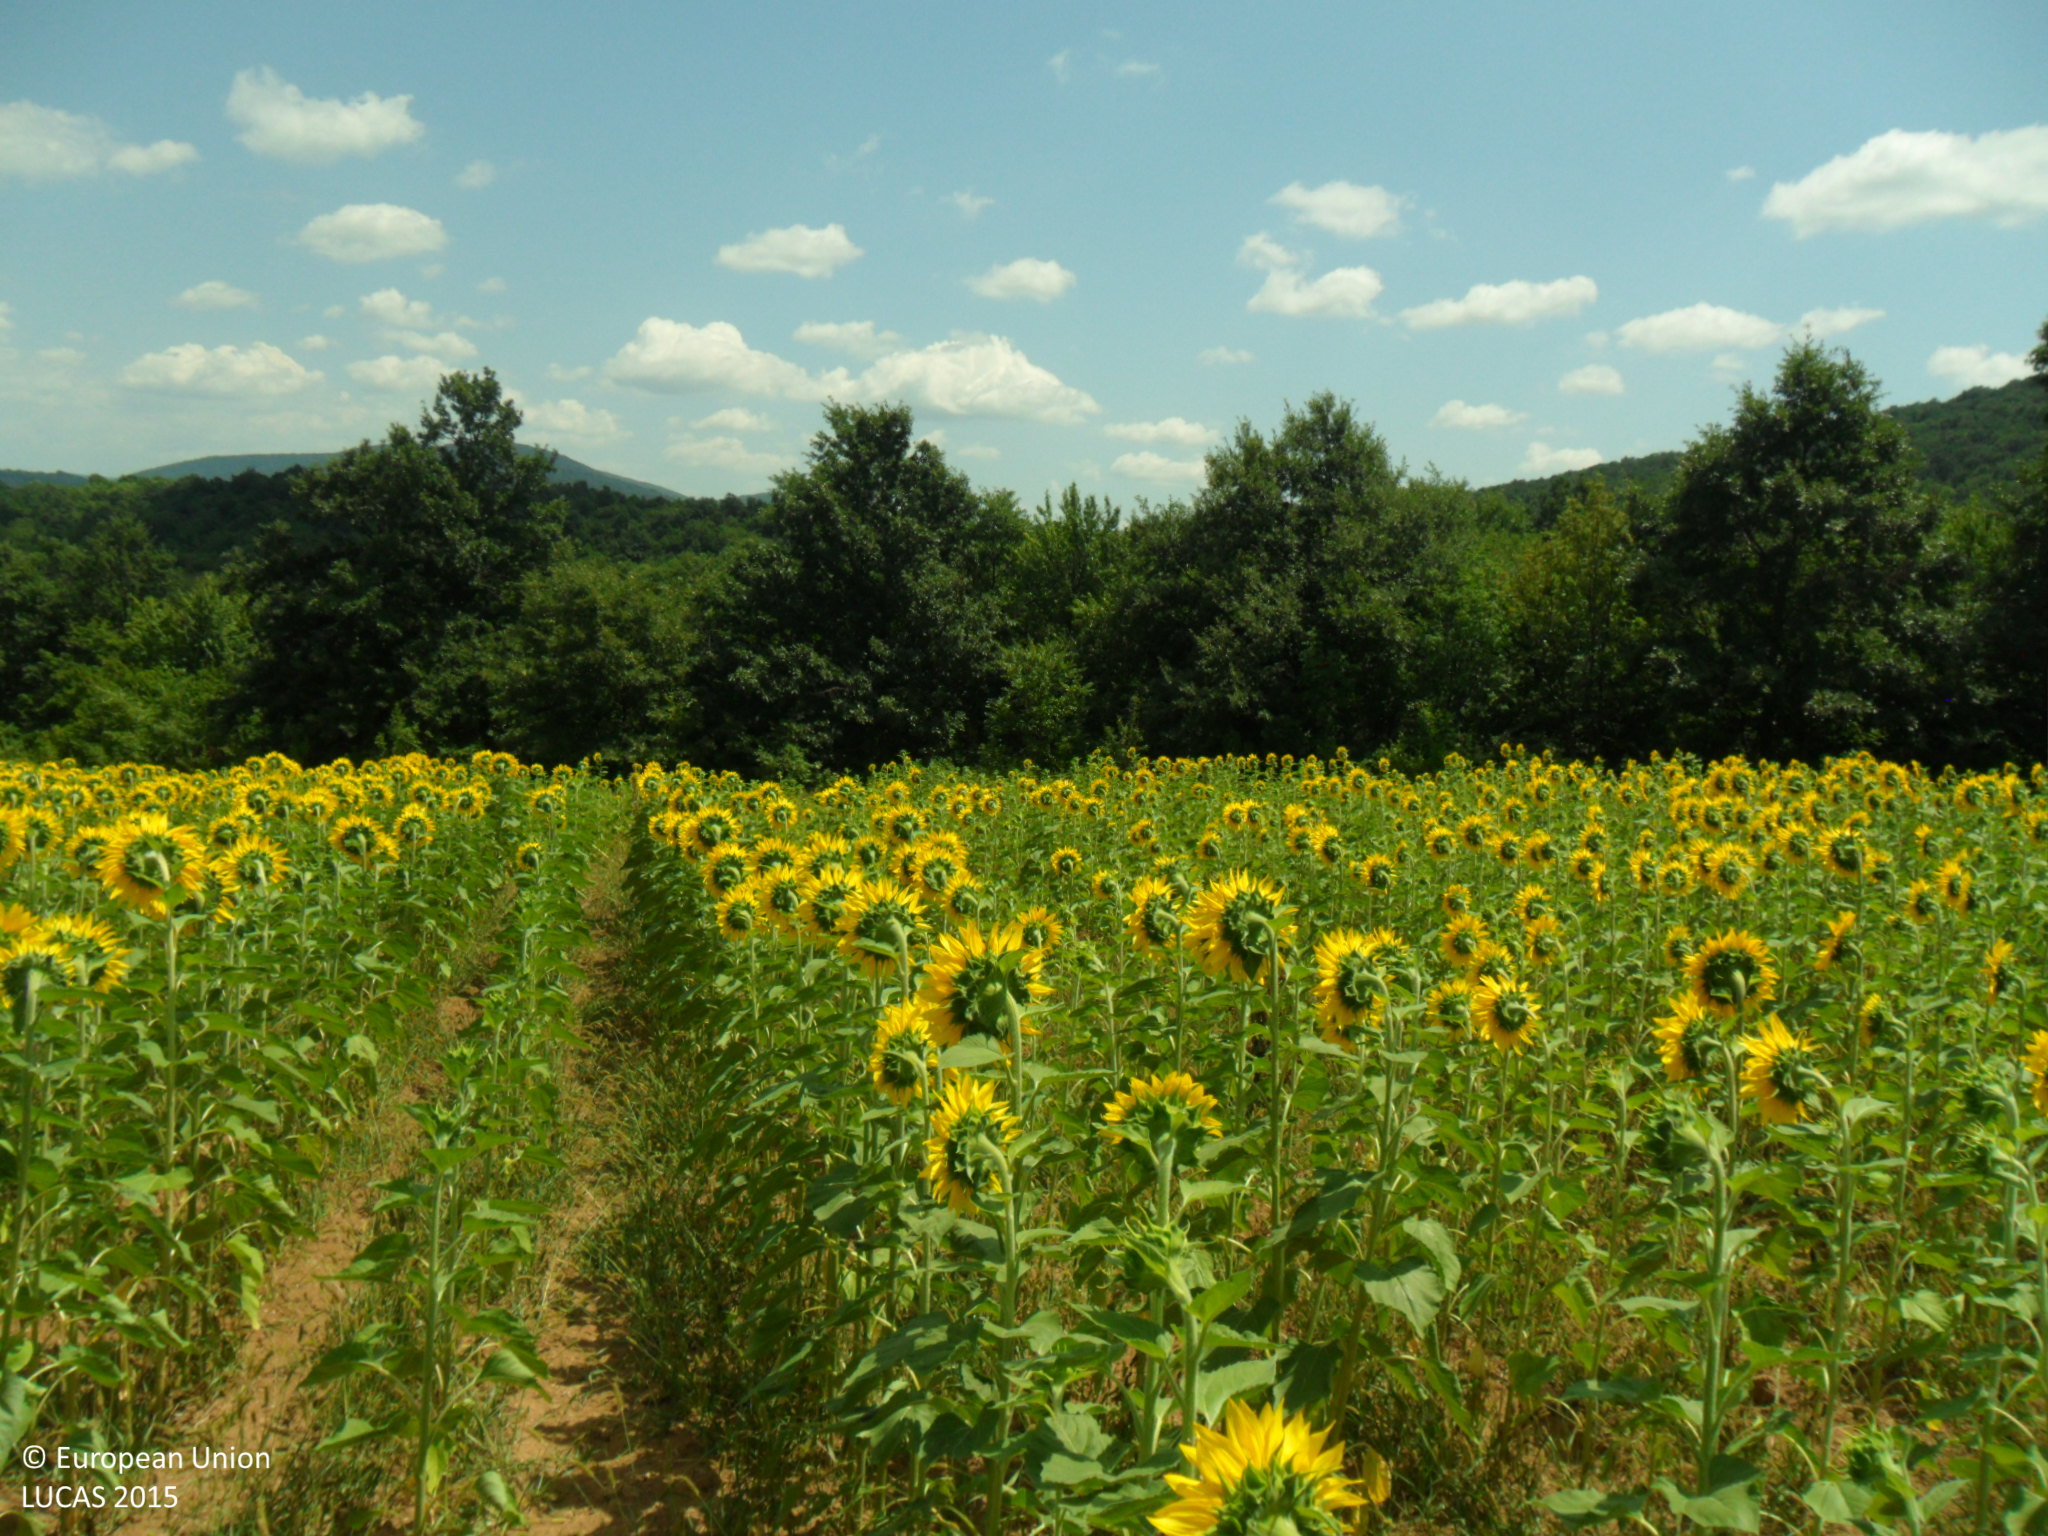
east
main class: Cropland
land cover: Sunflower
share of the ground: > 75 %
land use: Agriculture (excluding fallow land and kitchen gardens)
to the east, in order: Sunflower; Broadleaved woodland; Shrubland with sparse tree cover; Broadleaved woodland; Shrubland with sparse tree cover
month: July
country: BG
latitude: 43.0431
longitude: 27.0152
